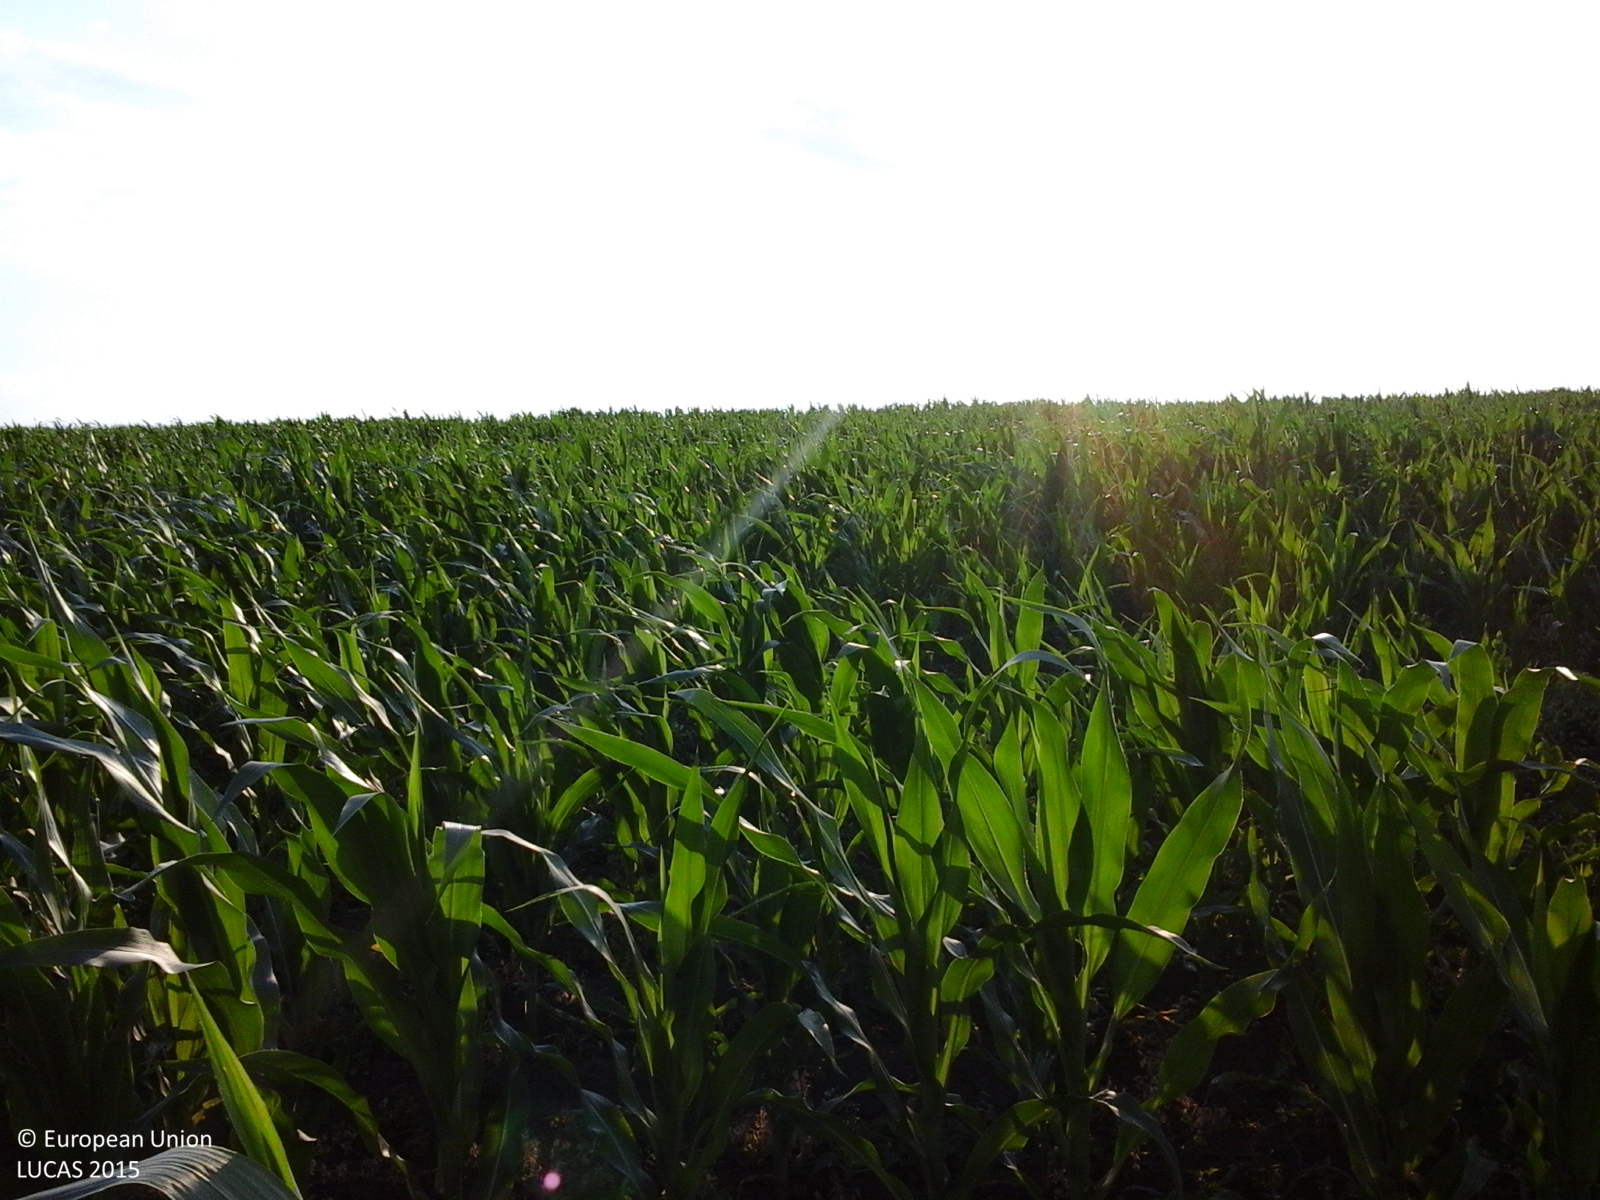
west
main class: Cropland
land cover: Maize
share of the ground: > 75 %
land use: Agriculture (excluding fallow land and kitchen gardens)
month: June
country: RO
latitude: 47.1692
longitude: 27.4360
